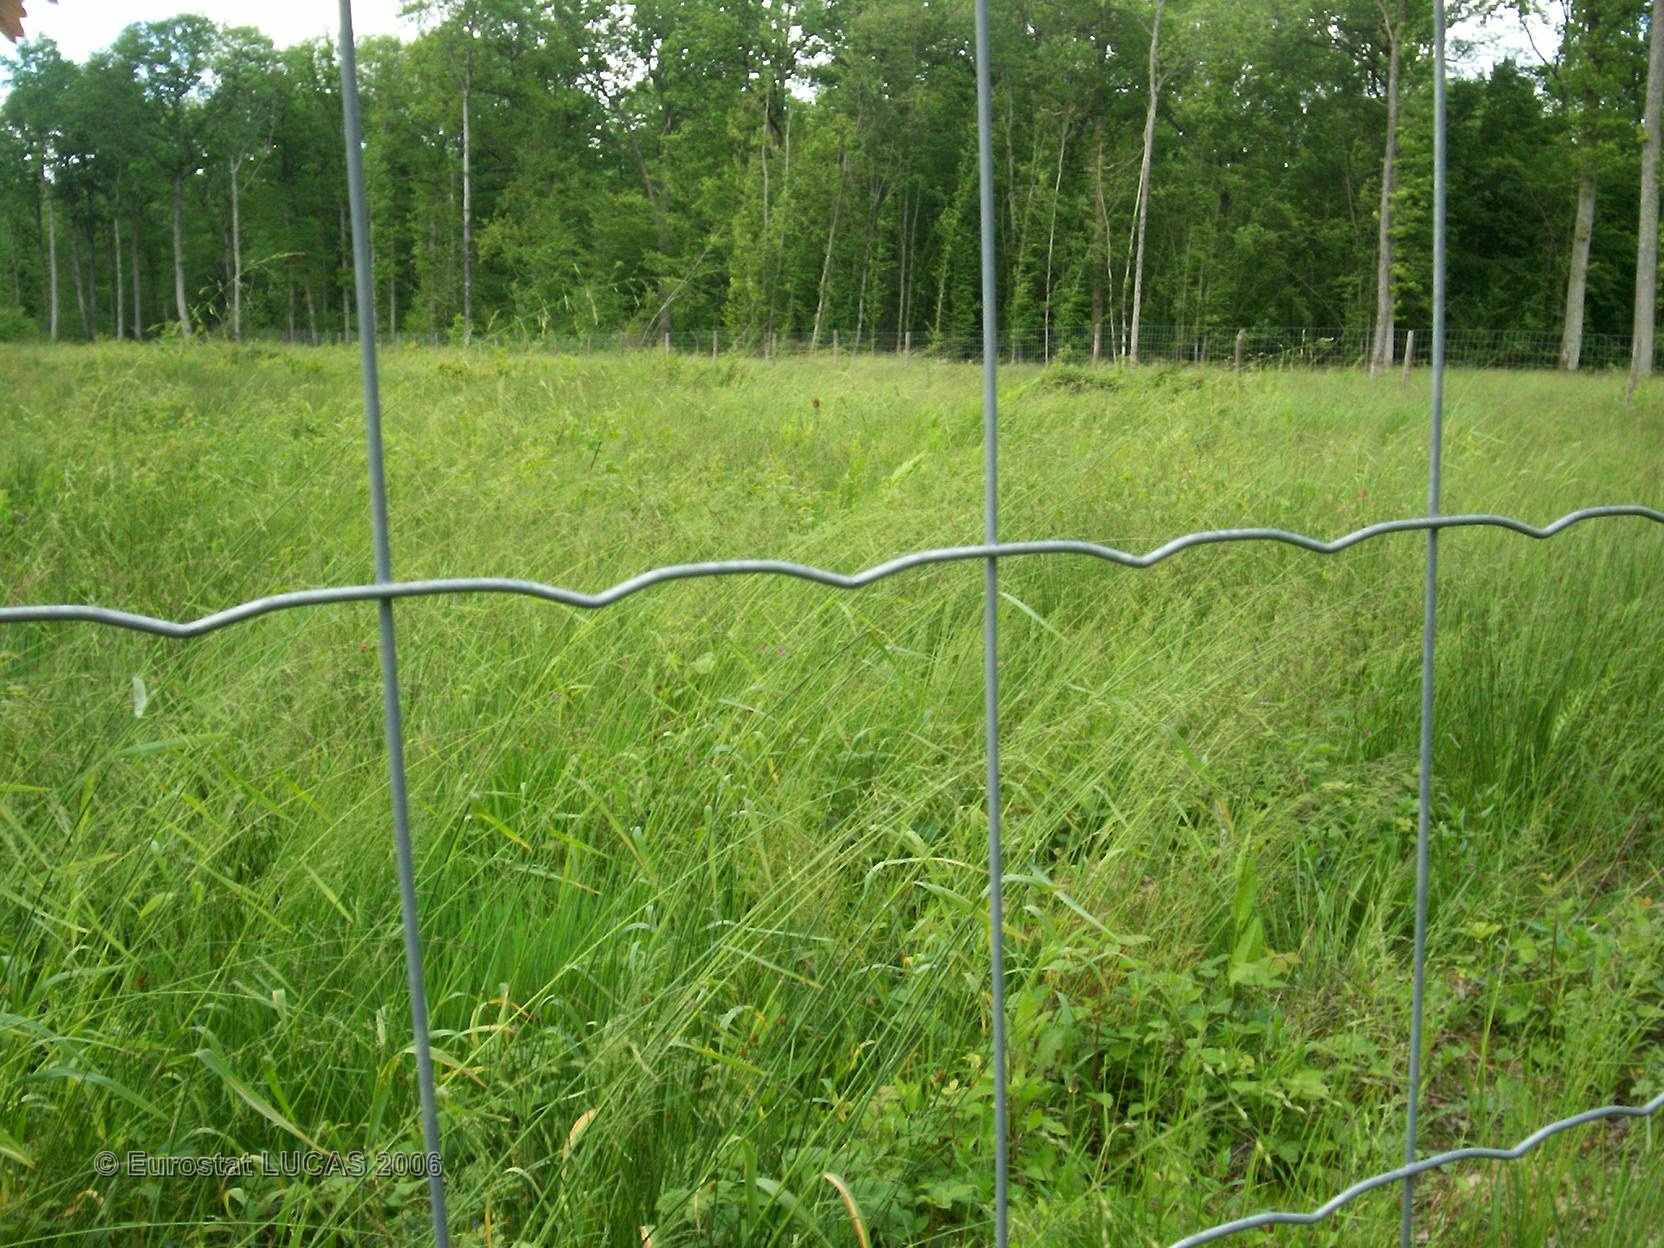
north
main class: Grassland
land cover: Grassland without tree/shrub cover
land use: Agriculture (excluding fallow land and kitchen gardens)
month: May
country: FR
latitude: 48.3650
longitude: 4.6662
